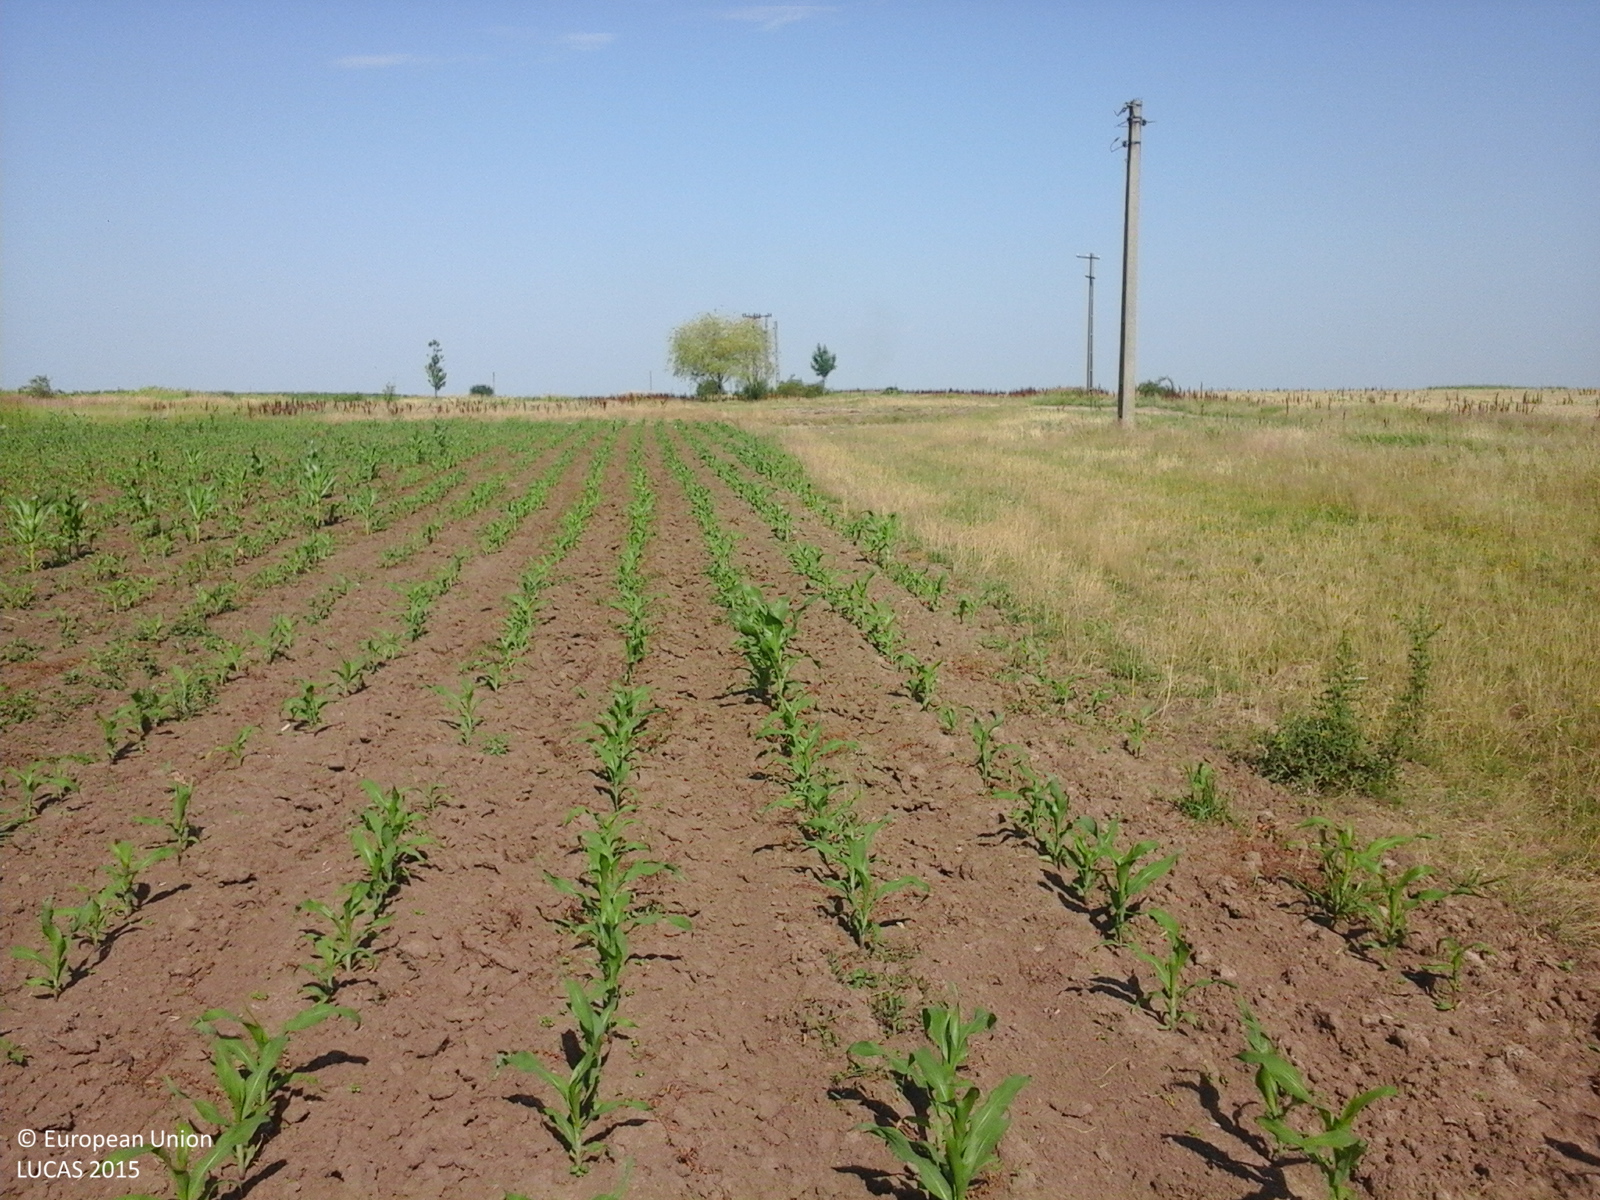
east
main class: Cropland
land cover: Maize
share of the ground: < 10 %
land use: Agriculture (excluding fallow land and kitchen gardens)
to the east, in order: Maize; Grassland without tree/shrub cover; Other bare soil; Spontaneously vegetated surfaces; Single bushes/trees; Maize; Spontaneously vegetated surfaces; Shruby margins
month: July
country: RO
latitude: 44.5506
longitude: 24.6384
